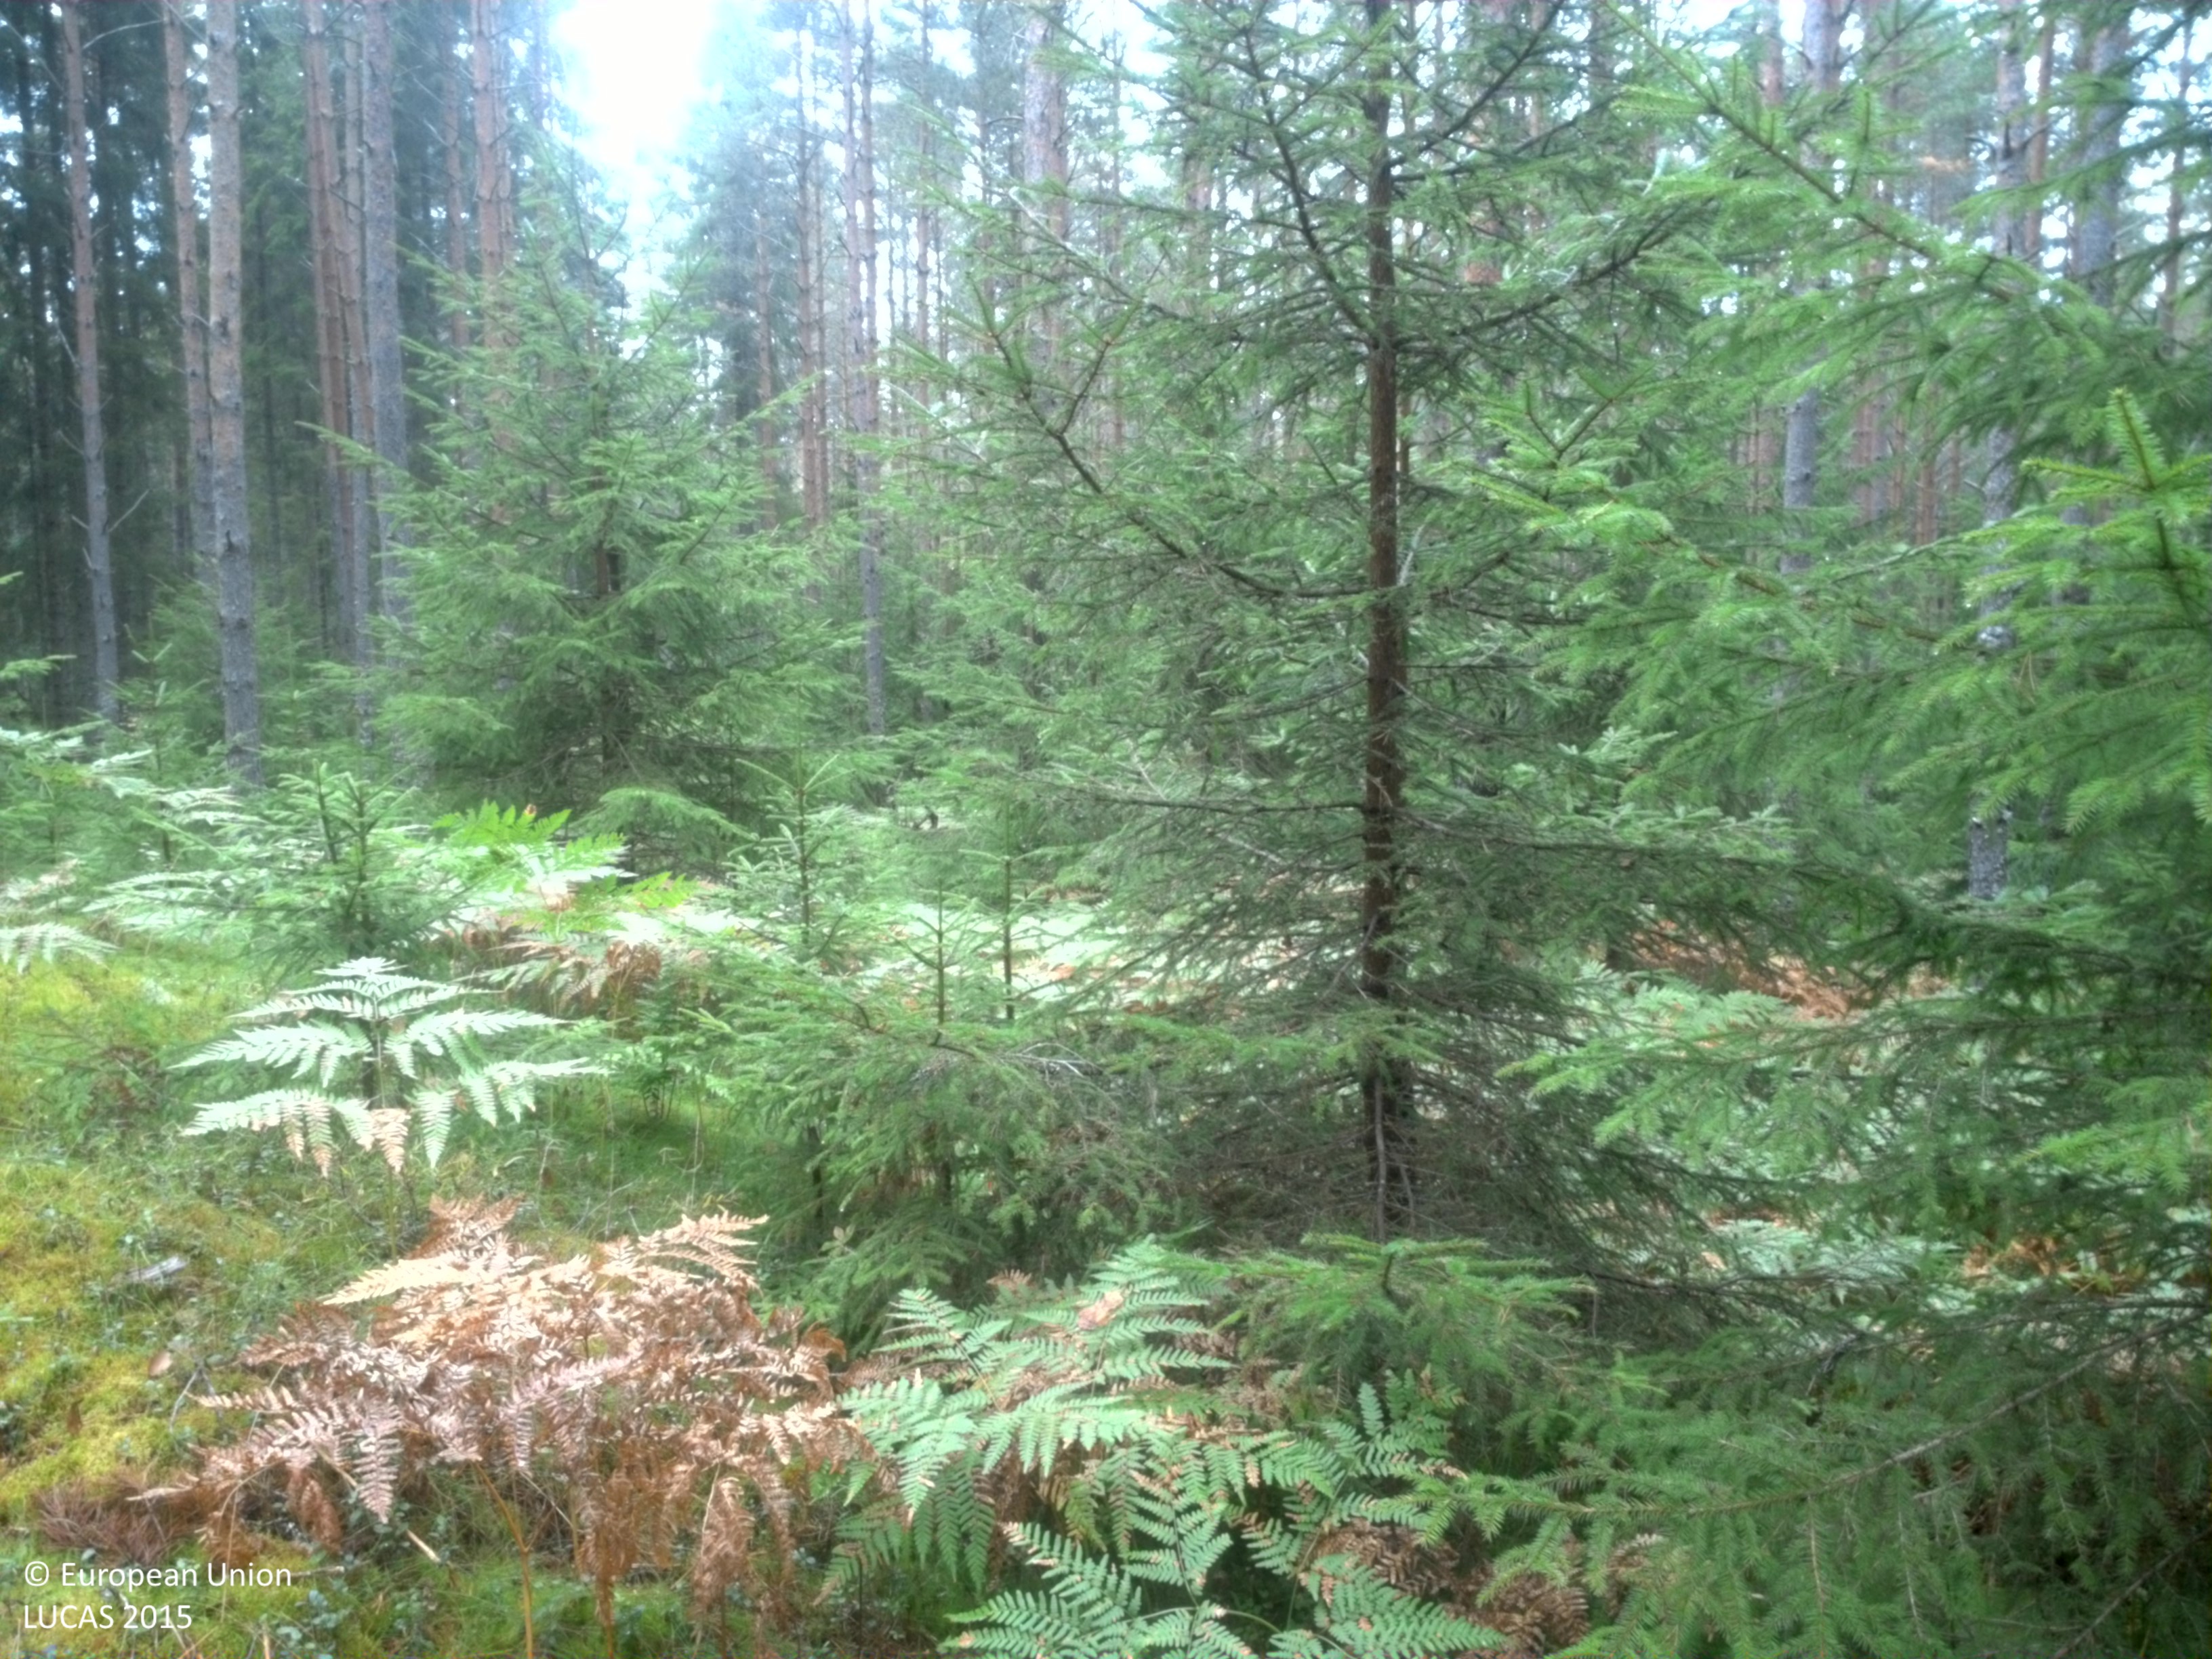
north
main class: Woodland
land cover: Pine dominated coniferous woodland
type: boreal forest
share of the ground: 50 - 75 %
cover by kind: coniferous forest trees 70 %, lichens and mosses 15 %, shrubs 10 %, herbaceous plants 5 %
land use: Forestry
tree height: > 5 m
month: September
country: SE
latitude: 59.6552
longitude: 15.5806
